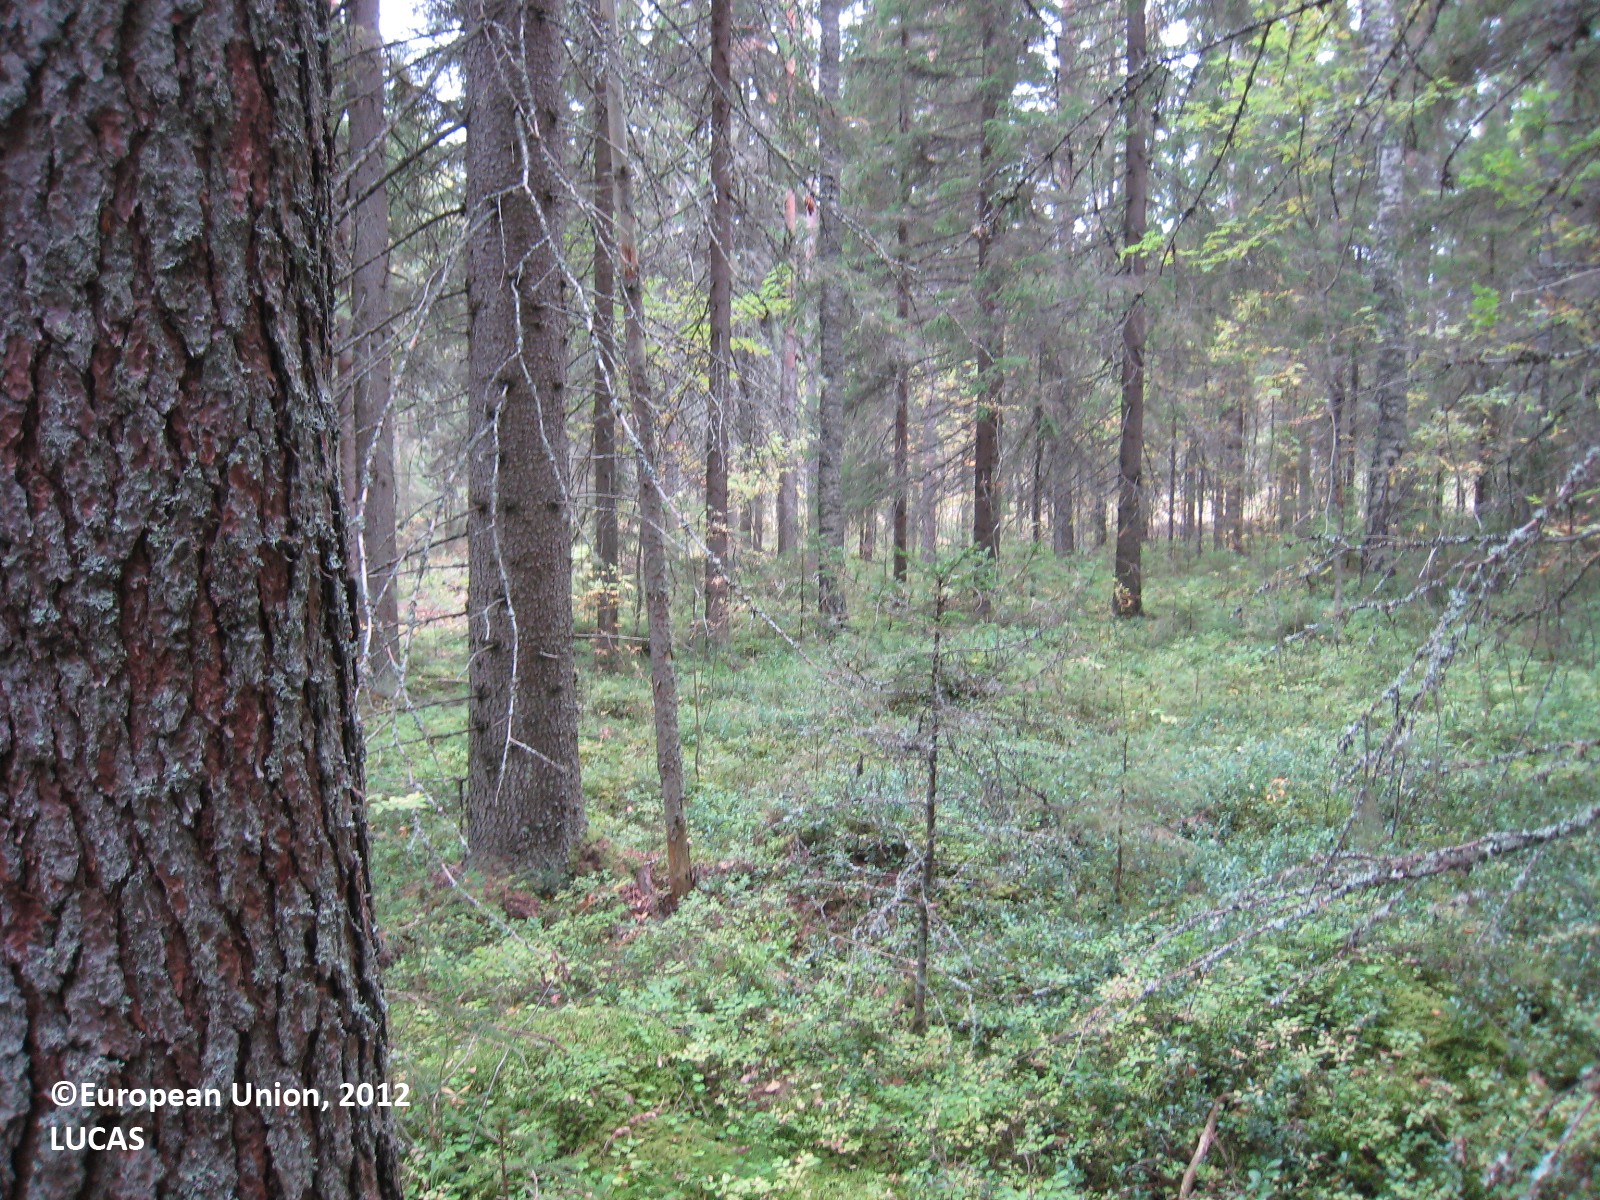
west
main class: Woodland
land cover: Spruce dominated coniferous woodland
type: boreal forest
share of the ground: > 75 %
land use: Forestry
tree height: > 5 m
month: September
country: FI
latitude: 62.7233
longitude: 26.5464
